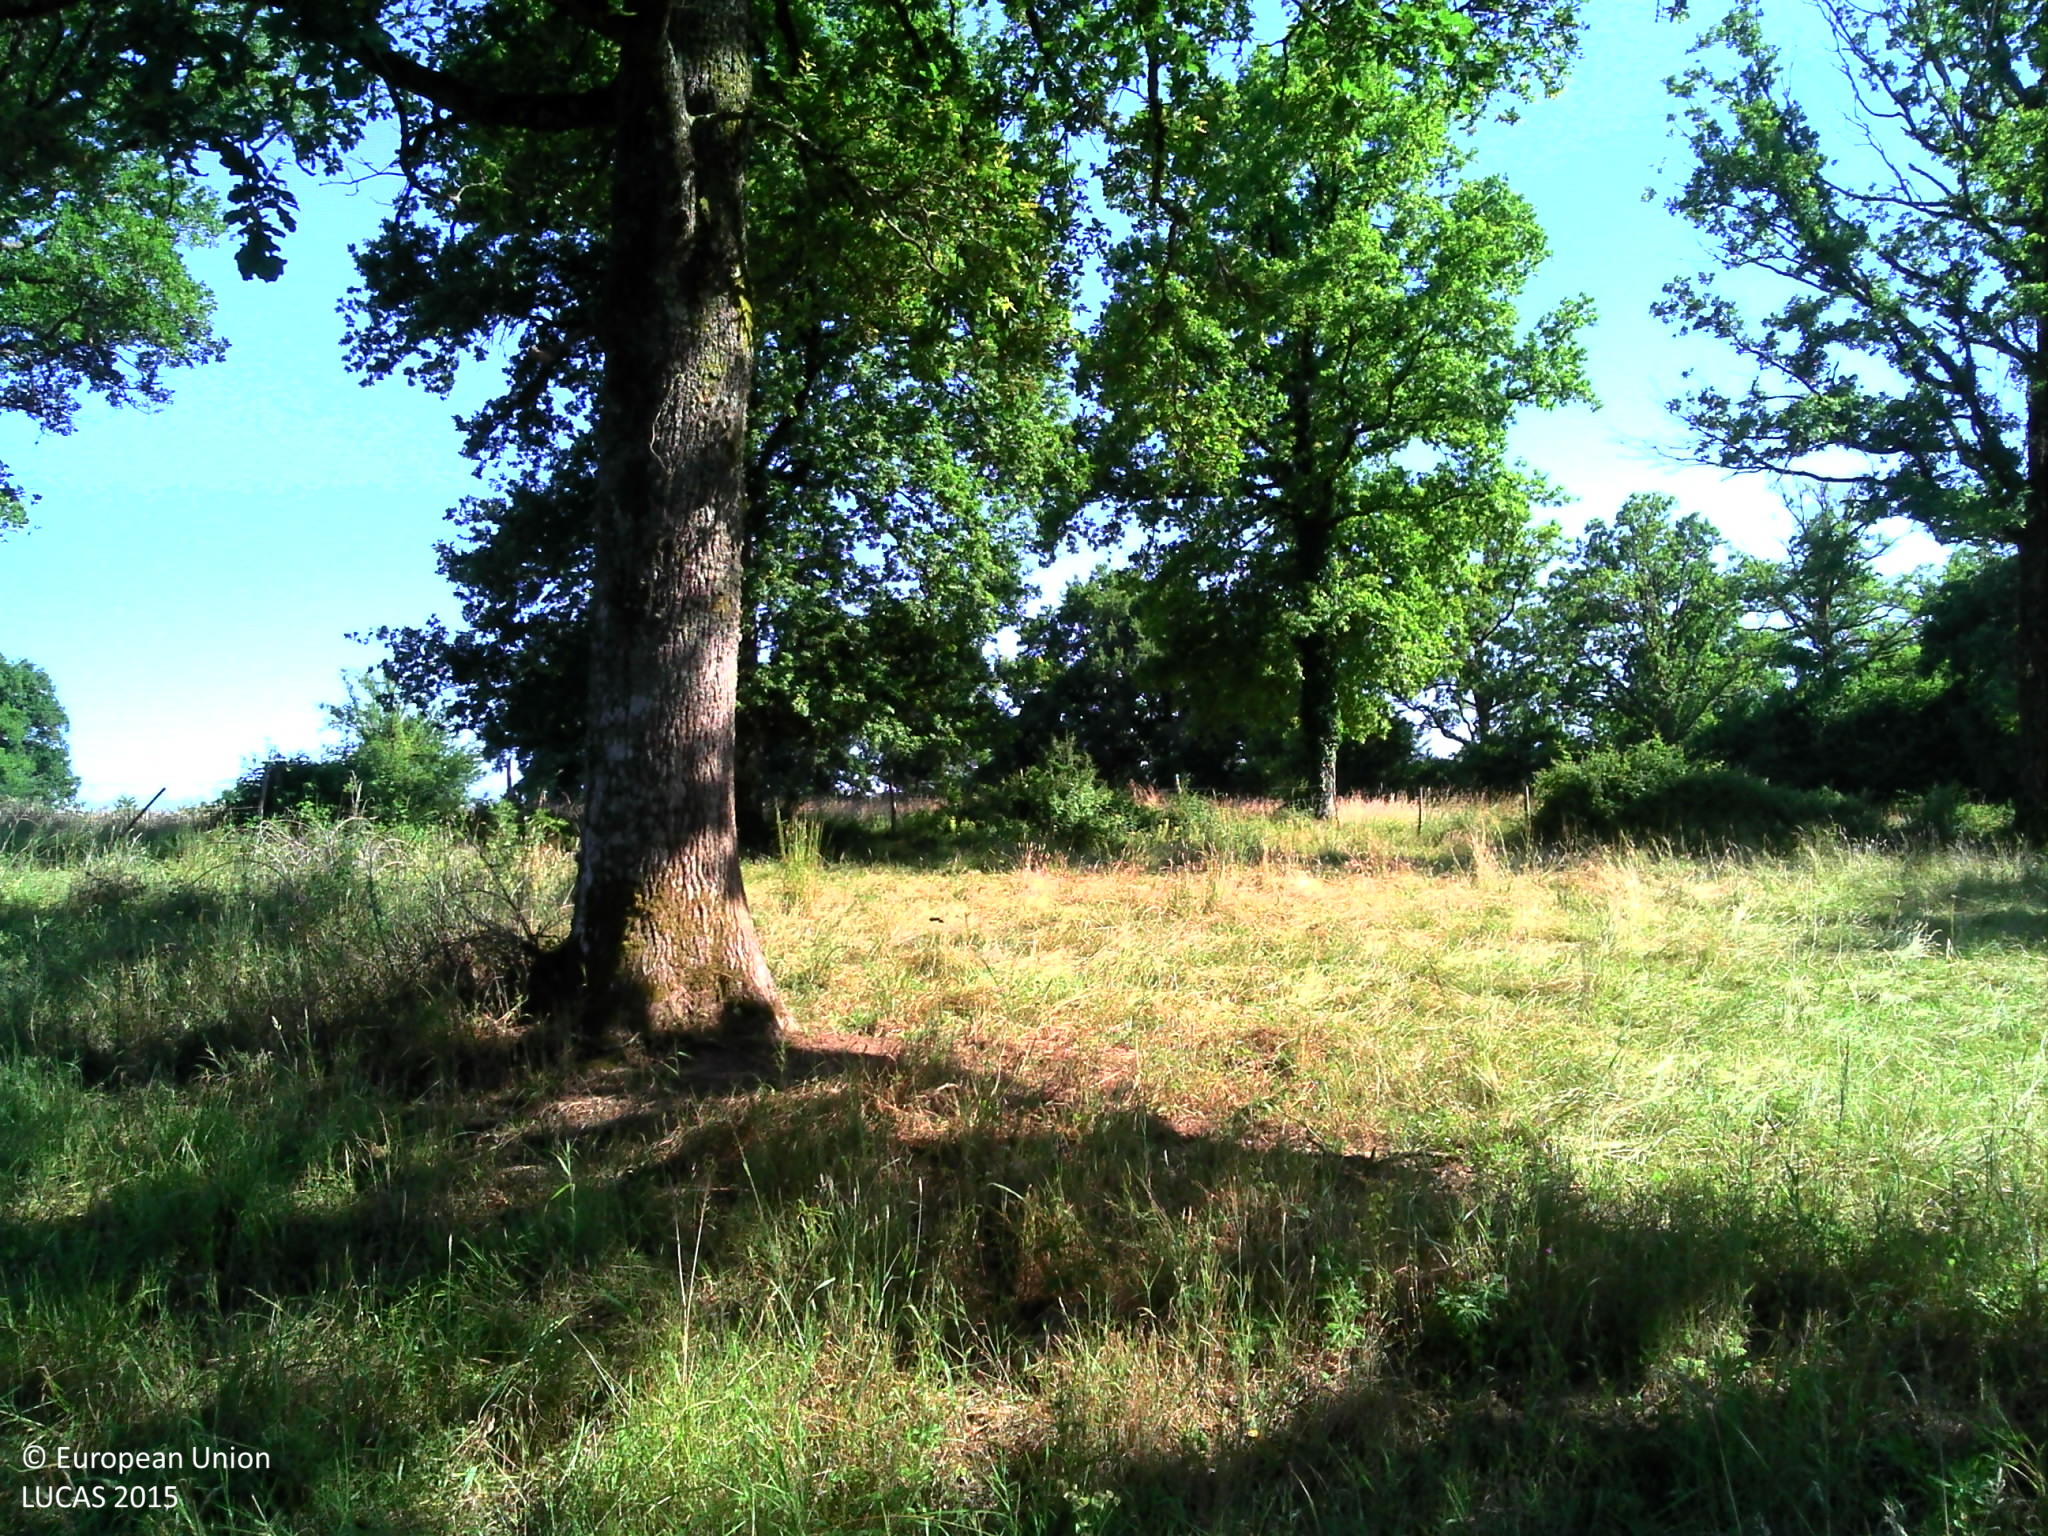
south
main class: Grassland
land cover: Grassland with sparse tree/shrub cover
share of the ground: > 75 %
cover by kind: herbaceous plants 95 %, broadleaved forest trees 5 %
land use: Agriculture (excluding fallow land and kitchen gardens)
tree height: > 5 m
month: June
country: FR
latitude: 45.8168
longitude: 0.6819
